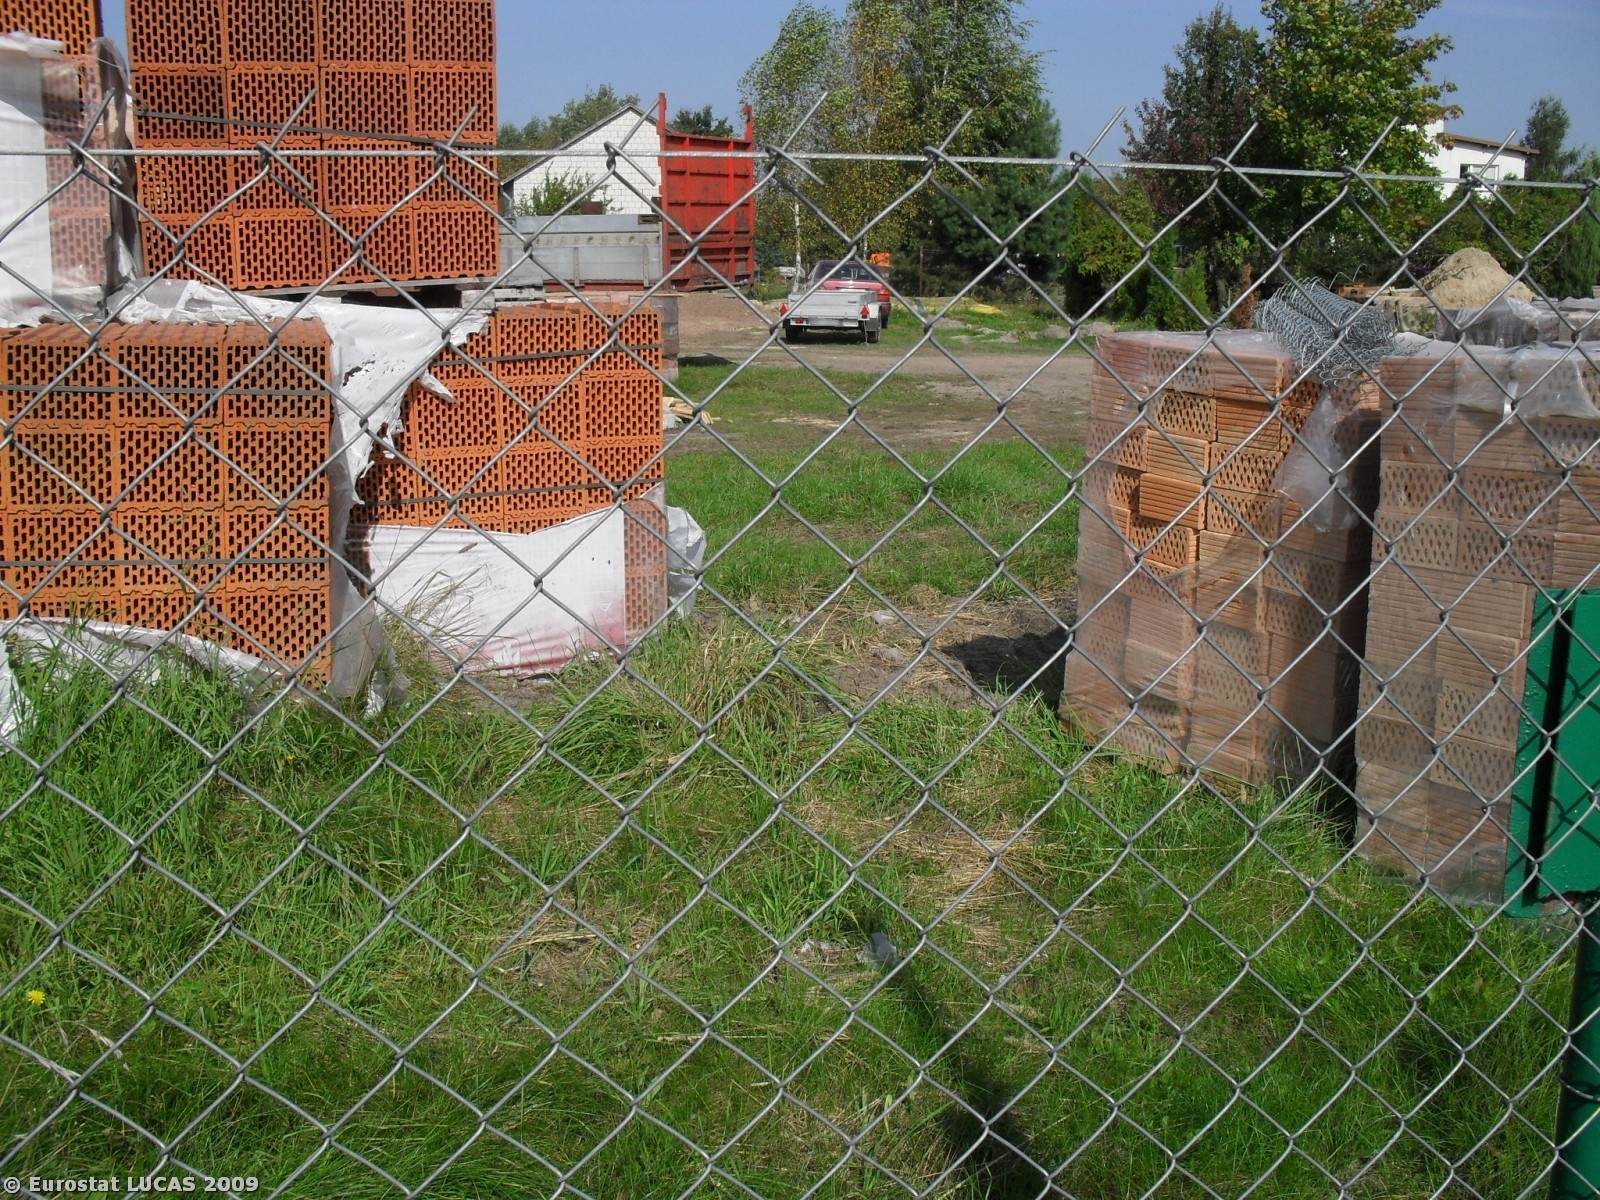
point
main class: Grassland
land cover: Grassland without tree/shrub cover
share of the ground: > 75 %
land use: Residential
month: September
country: PL
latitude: 52.0057
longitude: 21.0435
